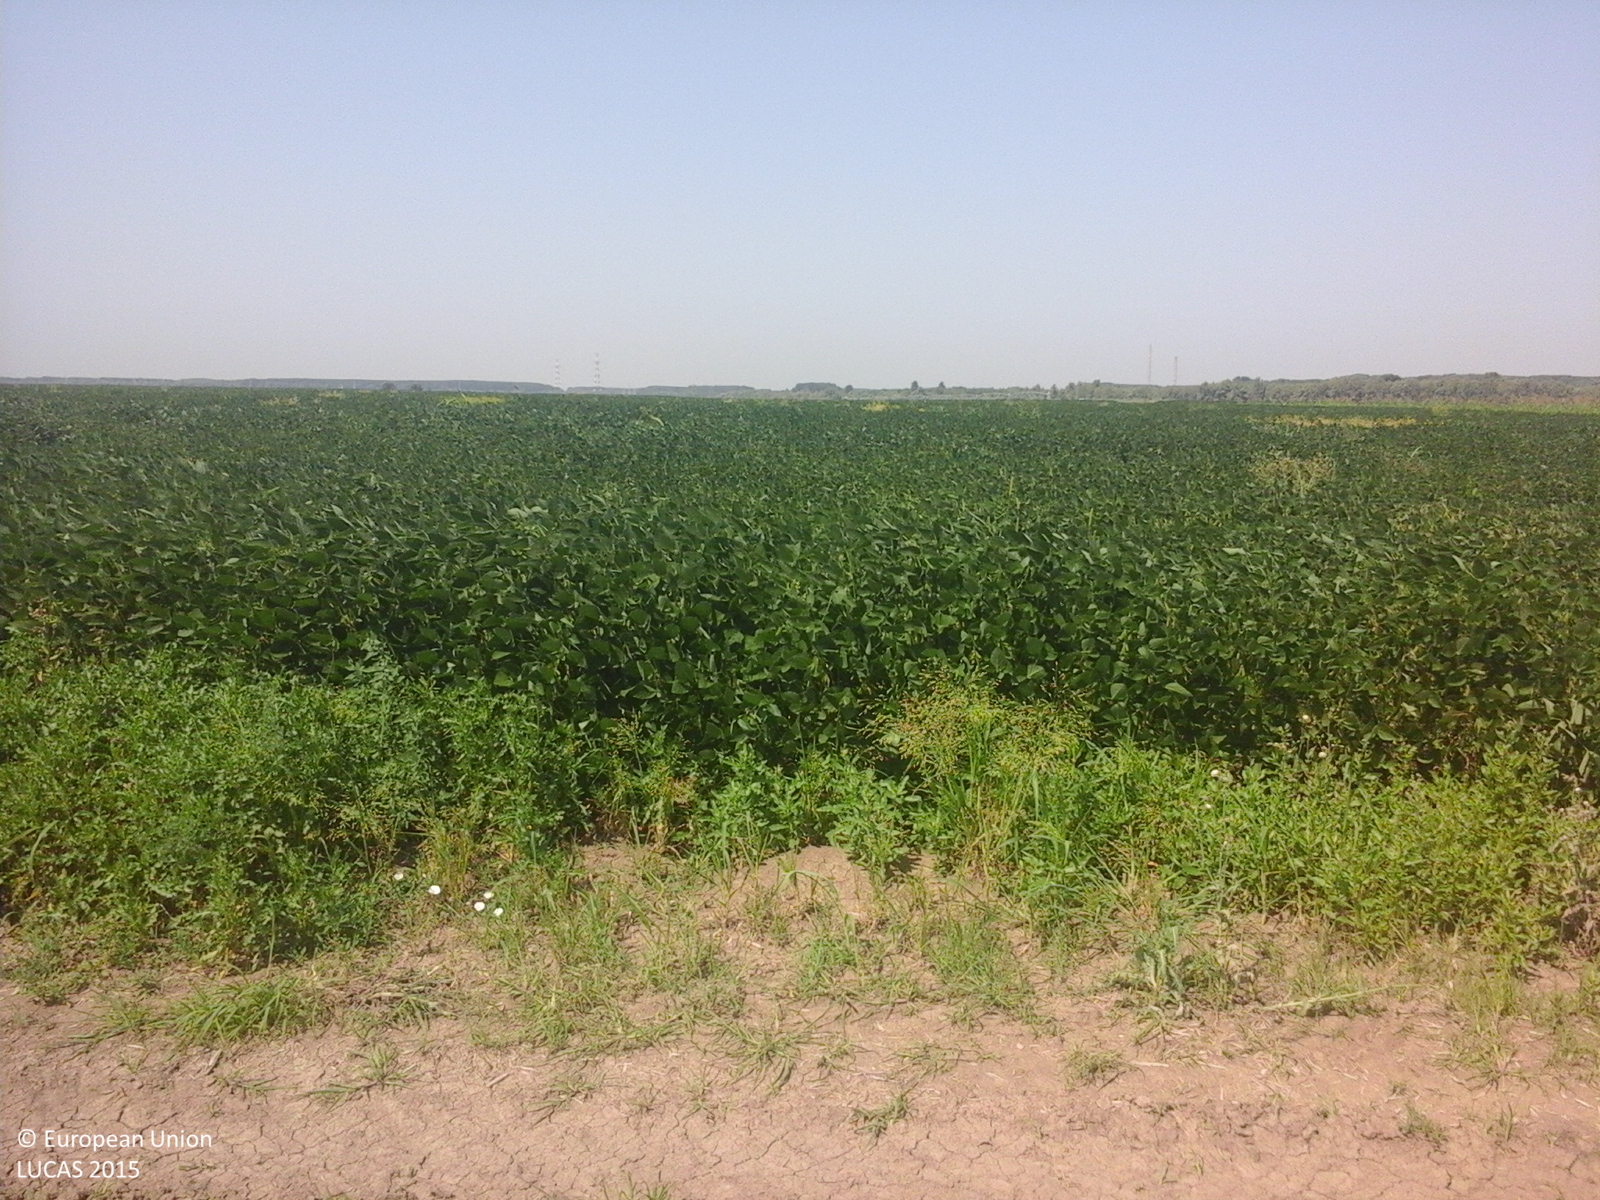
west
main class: Cropland
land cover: Soya
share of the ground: > 75 %
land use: Agriculture (excluding fallow land and kitchen gardens)
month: August
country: RO
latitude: 45.1559
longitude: 28.0124
